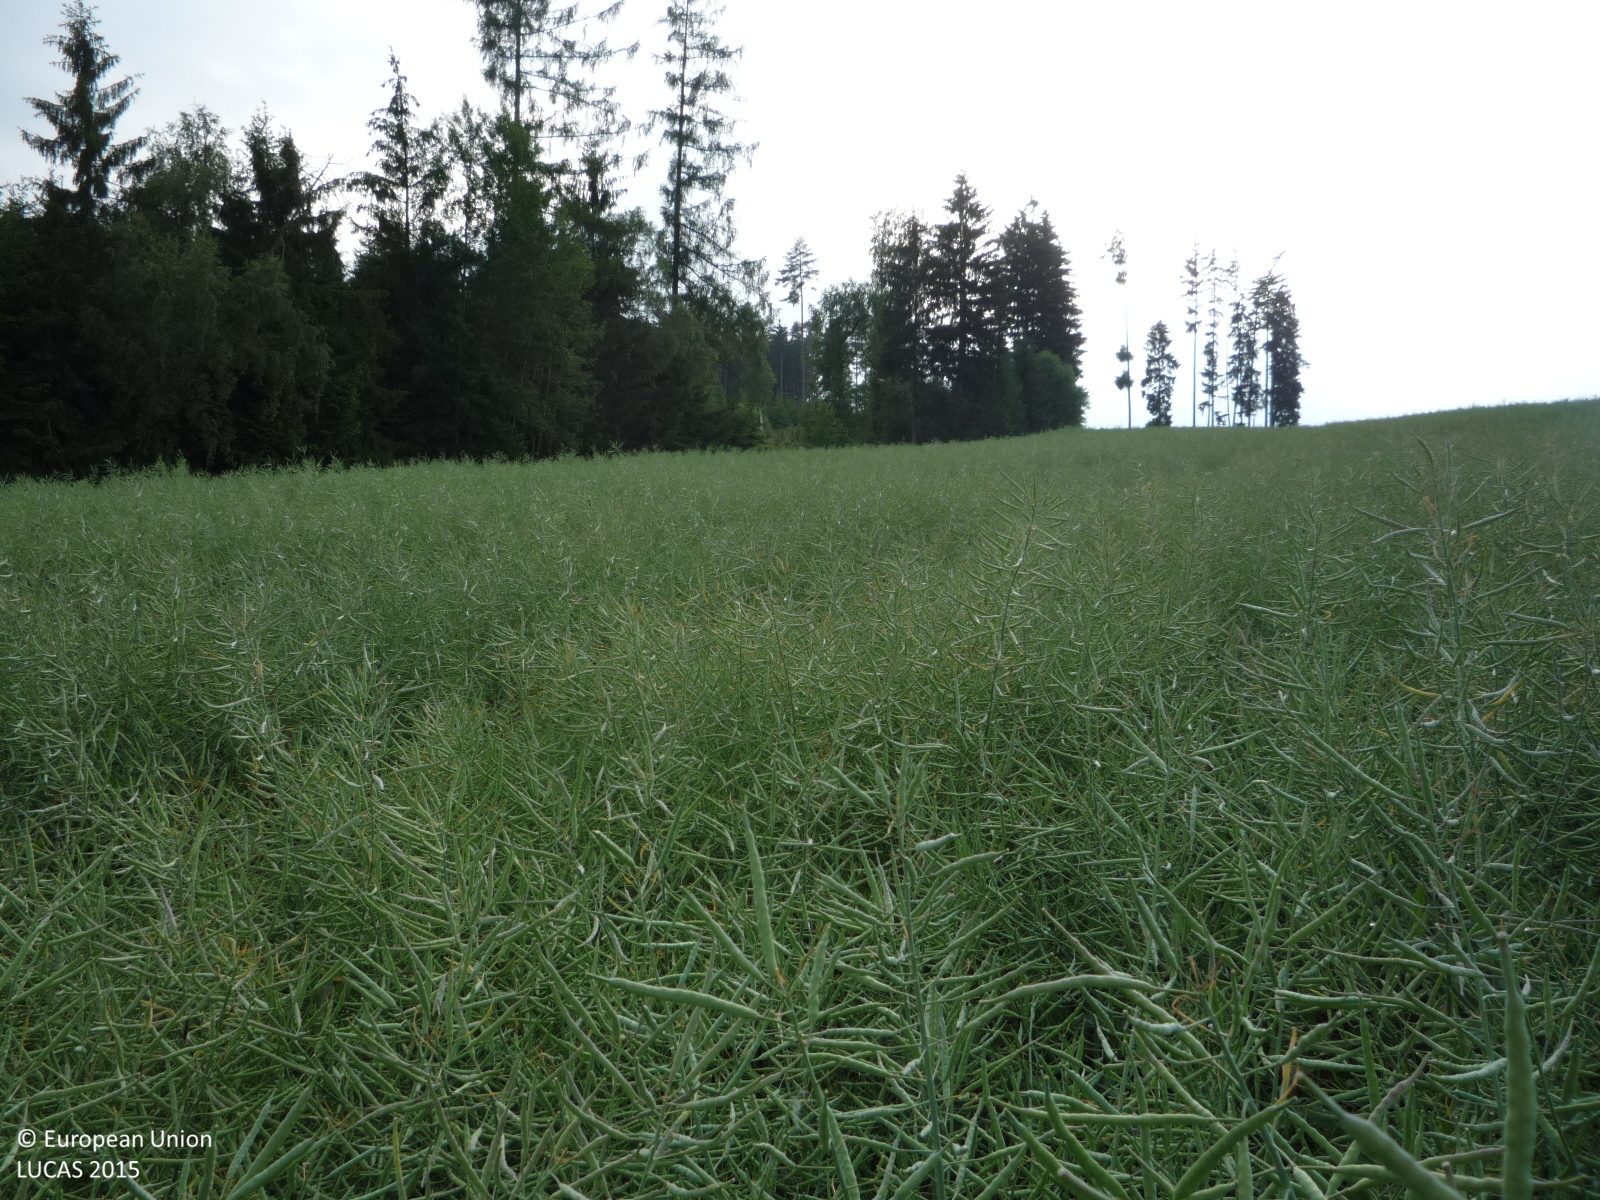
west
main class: Cropland
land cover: Rape and turnip rape
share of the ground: > 75 %
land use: Agriculture (excluding fallow land and kitchen gardens)
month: June
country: CZ
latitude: 49.6909
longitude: 15.1180
